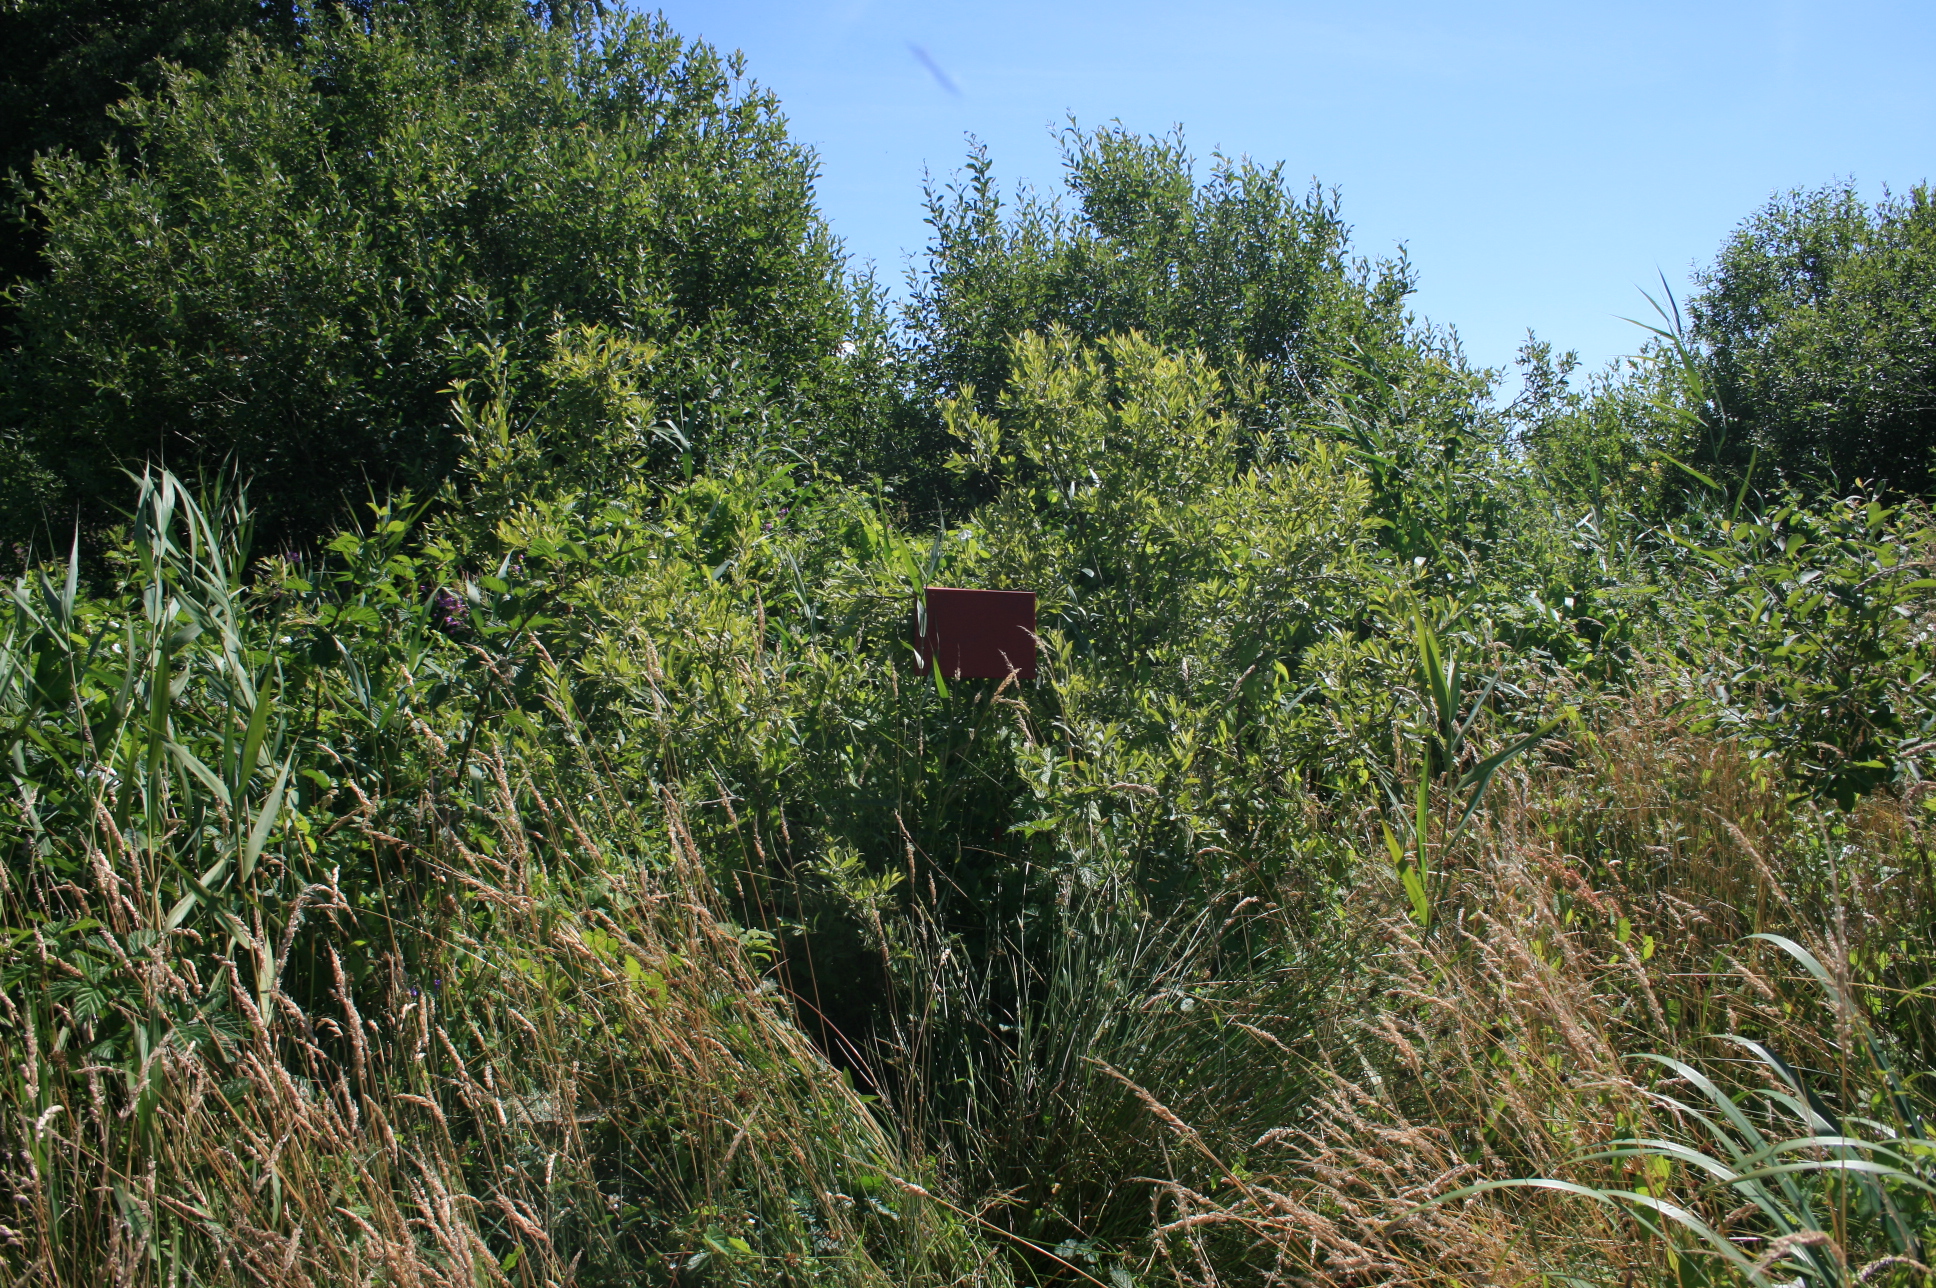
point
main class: Shrubland
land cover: Shrubland with sparse tree cover
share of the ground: 50 - 75 %
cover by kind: herbaceous plants 65 %, shrubs 30 %, broadleaved forest trees 5 %
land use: Semi-natural and natural areas not in use
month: July
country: LT
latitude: 55.4725
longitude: 21.2587
